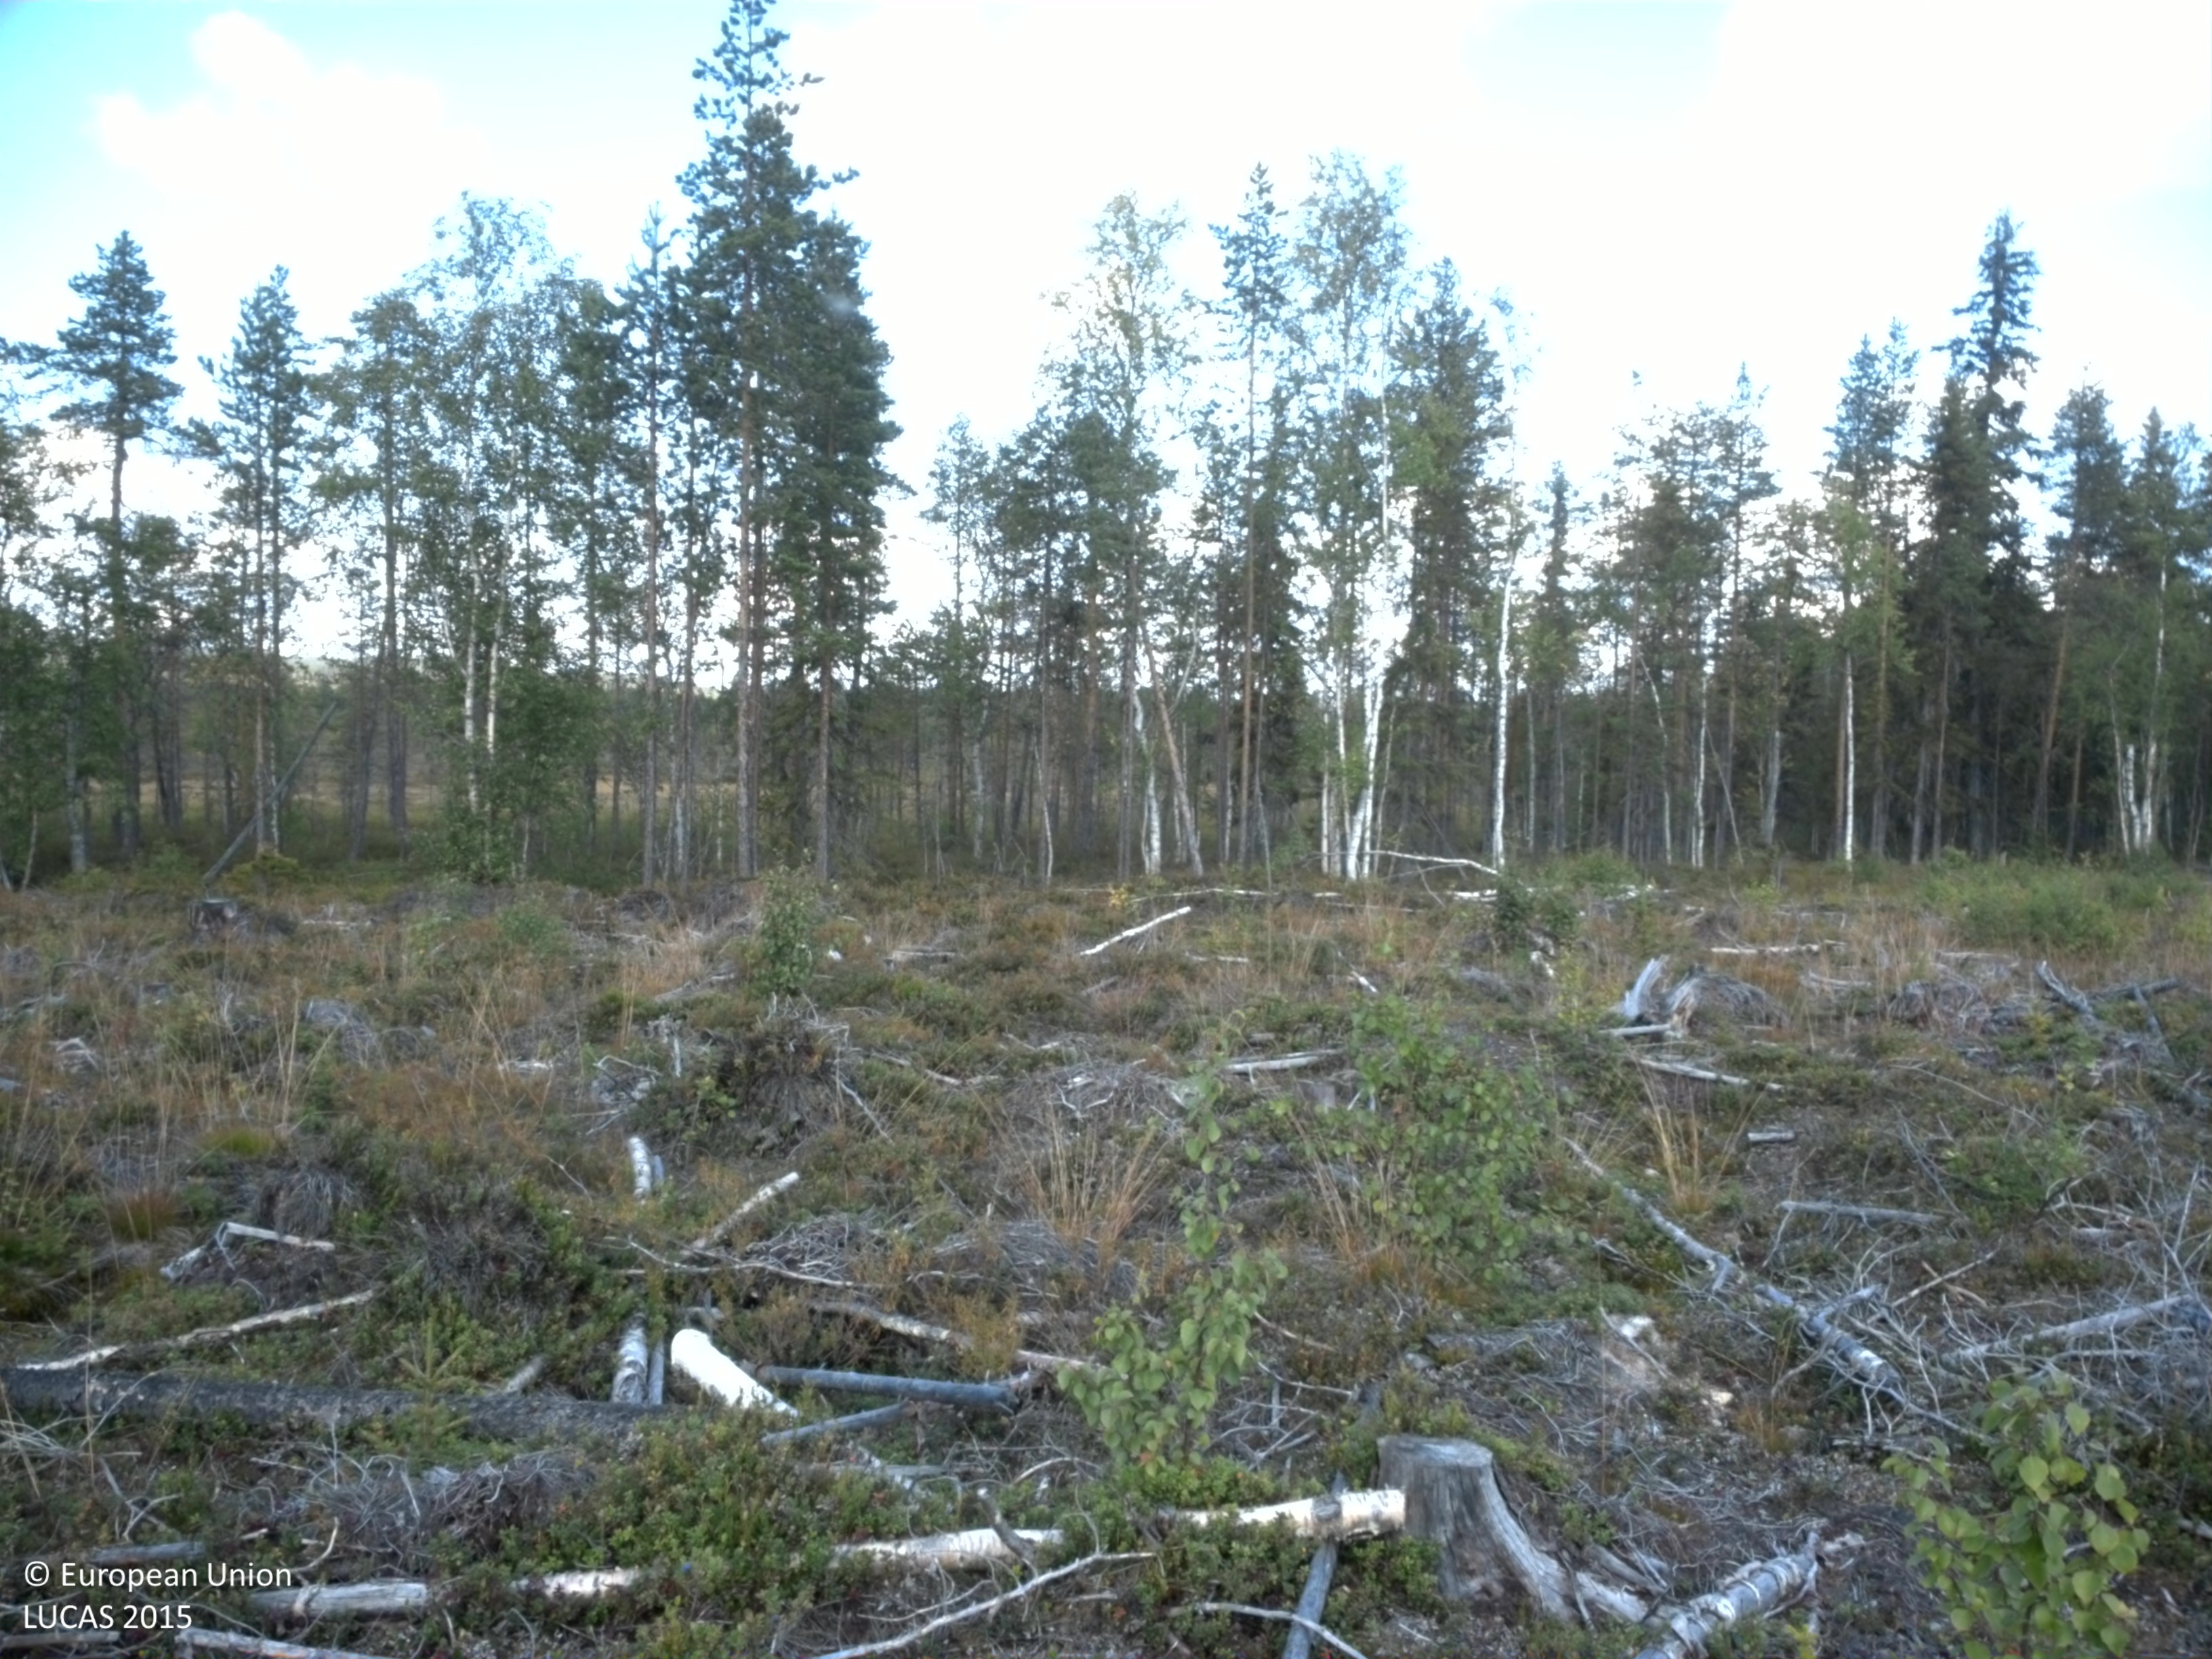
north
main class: Shrubland
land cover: Shrubland with sparse tree cover
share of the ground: > 75 %
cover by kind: shrubs 80 %, lichens and mosses 10 %, broadleaved forest trees 5 %, herbaceous plants 5 %
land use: Forestry
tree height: < 5 m
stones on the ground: 10 - 25 %
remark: Clear cut
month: August
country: SE
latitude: 64.5606
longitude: 19.0036
